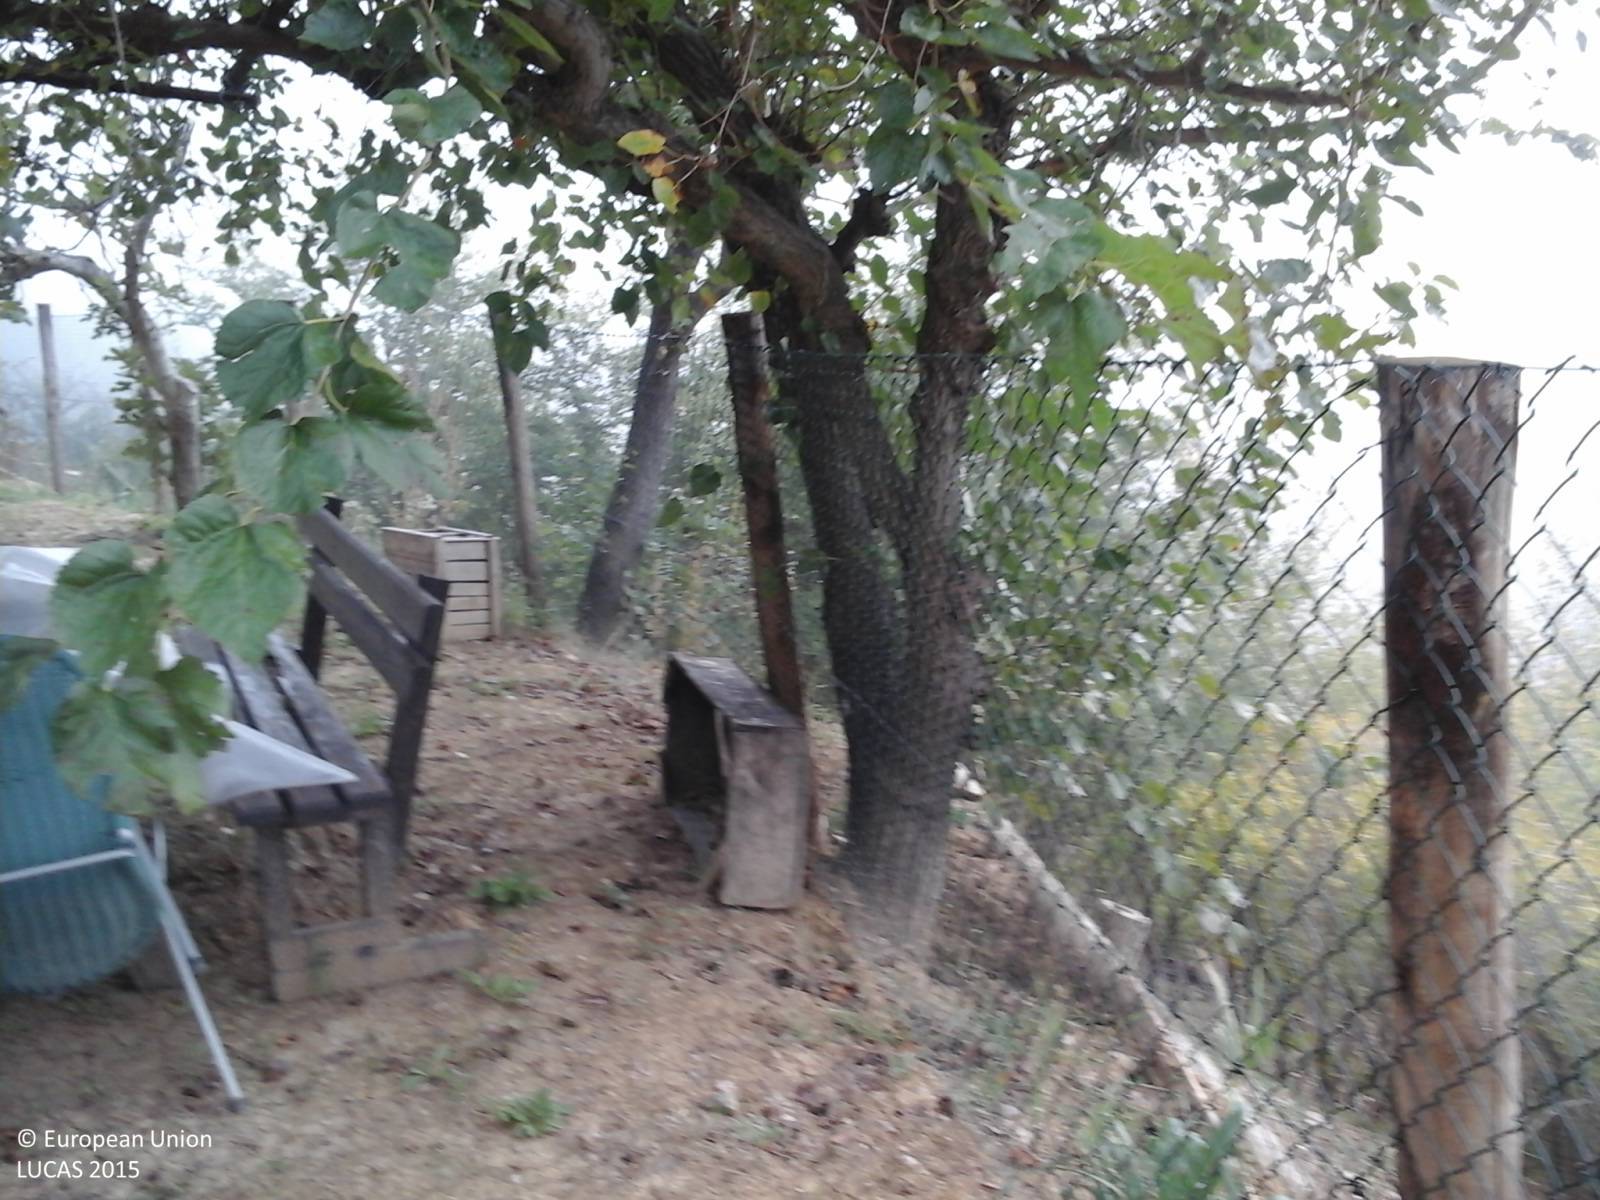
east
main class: Grassland
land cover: Grassland with sparse tree/shrub cover
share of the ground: > 75 %
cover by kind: herbaceous plants 95 %, broadleaved forest trees 5 %
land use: Agriculture (excluding fallow land and kitchen gardens)
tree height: < 5 m
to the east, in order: Grassland with sparse tree/shrub cover; Broadleaved woodland; Tracks; Broadleaved woodland; Grassland with sparse tree/shrub cover; Sand; Grassland with sparse tree/shrub cover; Broadleaved woodland
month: October
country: IT
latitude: 42.7701
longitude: 12.4001
